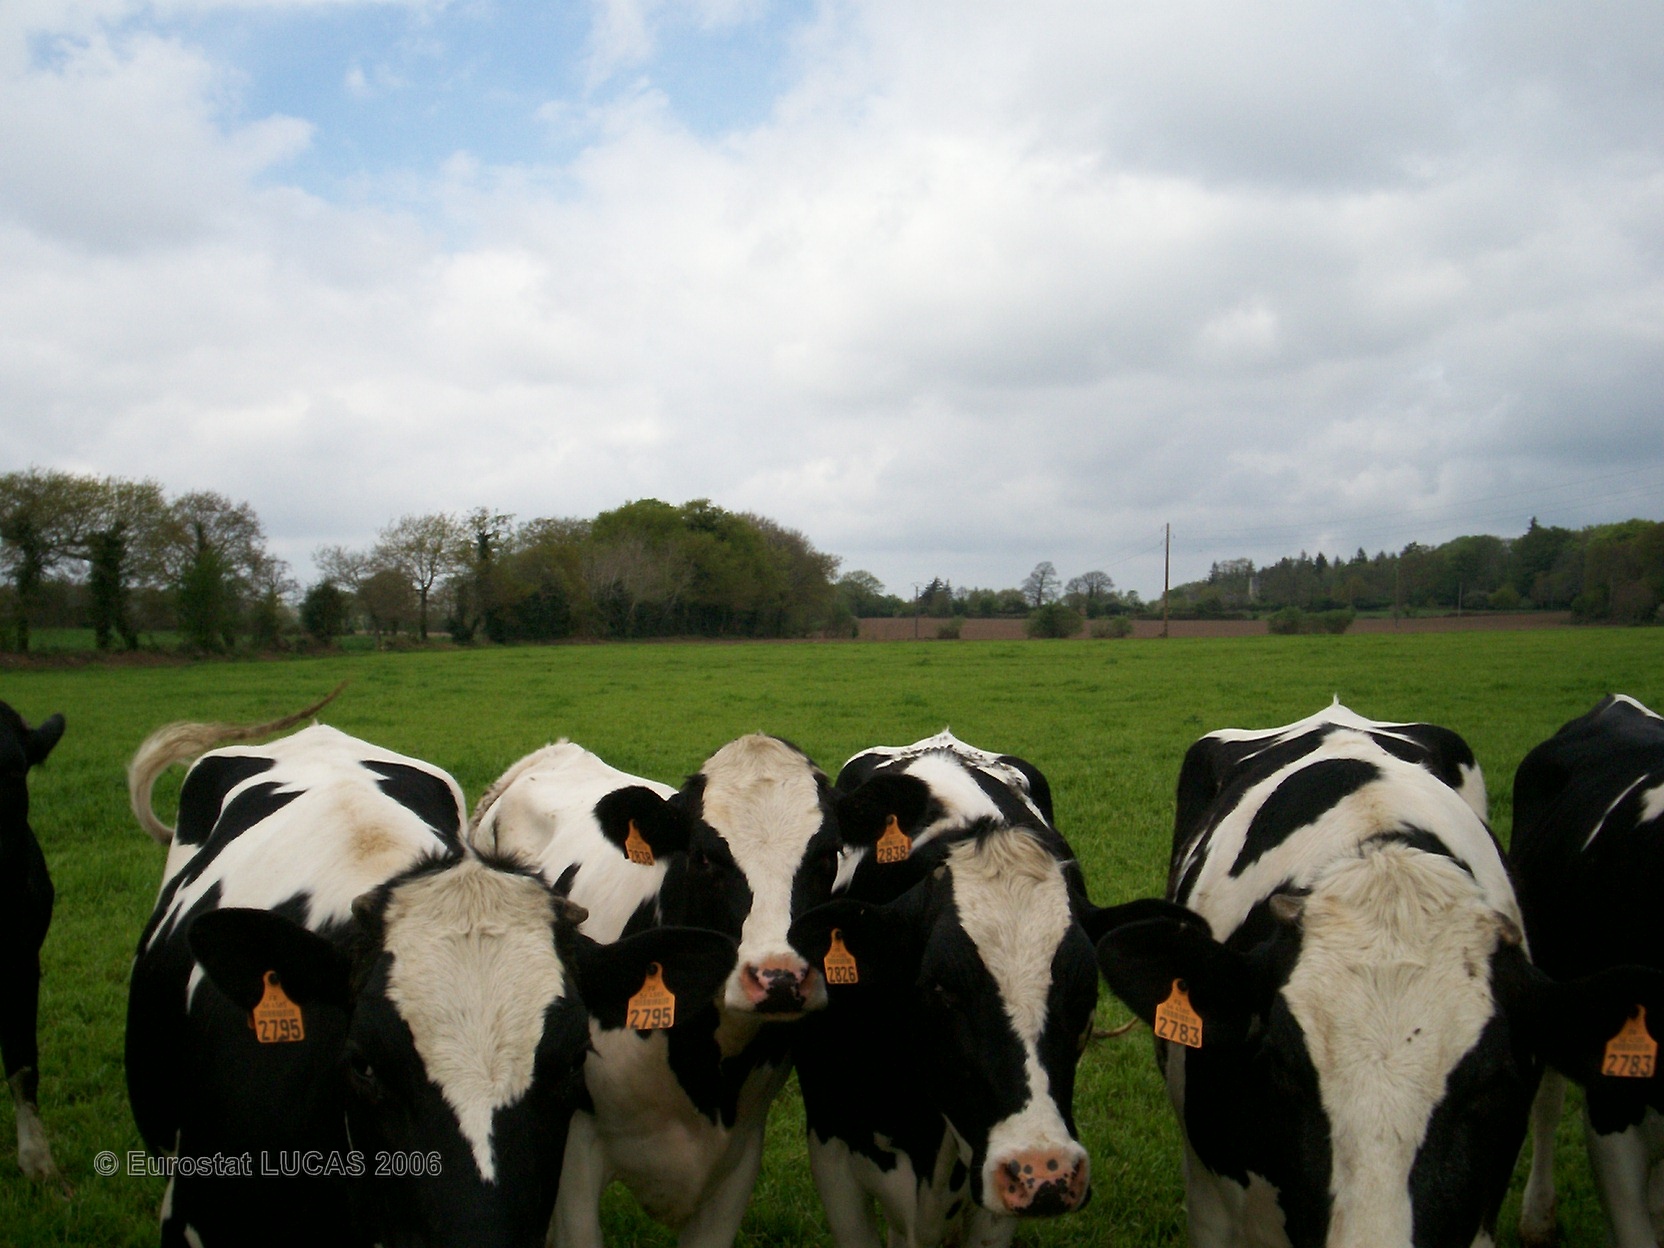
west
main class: Grassland
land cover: Grassland without tree/shrub cover
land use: Agriculture (excluding fallow land and kitchen gardens)
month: May
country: FR
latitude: 47.6531
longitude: -2.6687
